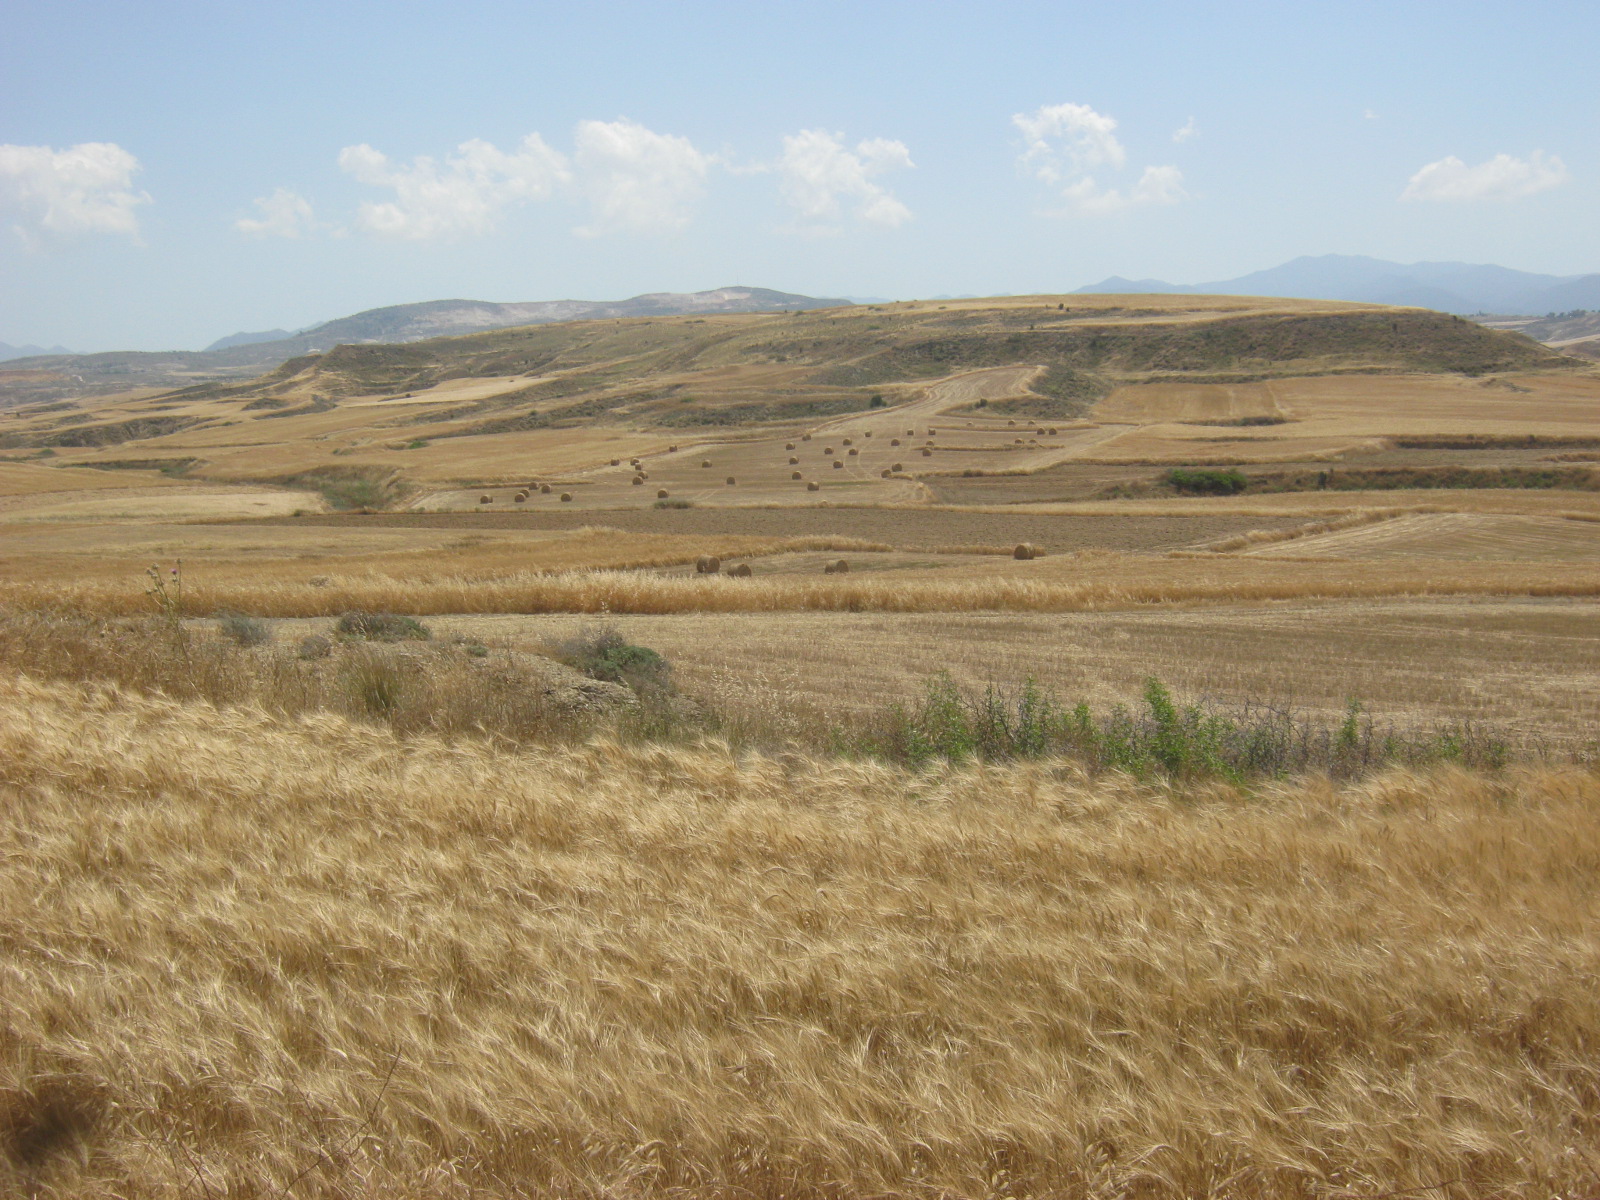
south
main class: Grassland
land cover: Spontaneously vegetated surfaces
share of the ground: 50 - 75 %
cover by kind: herbaceous plants 100 %
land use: Semi-natural and natural areas not in use
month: May
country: CY
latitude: 35.1007
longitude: 33.1207
